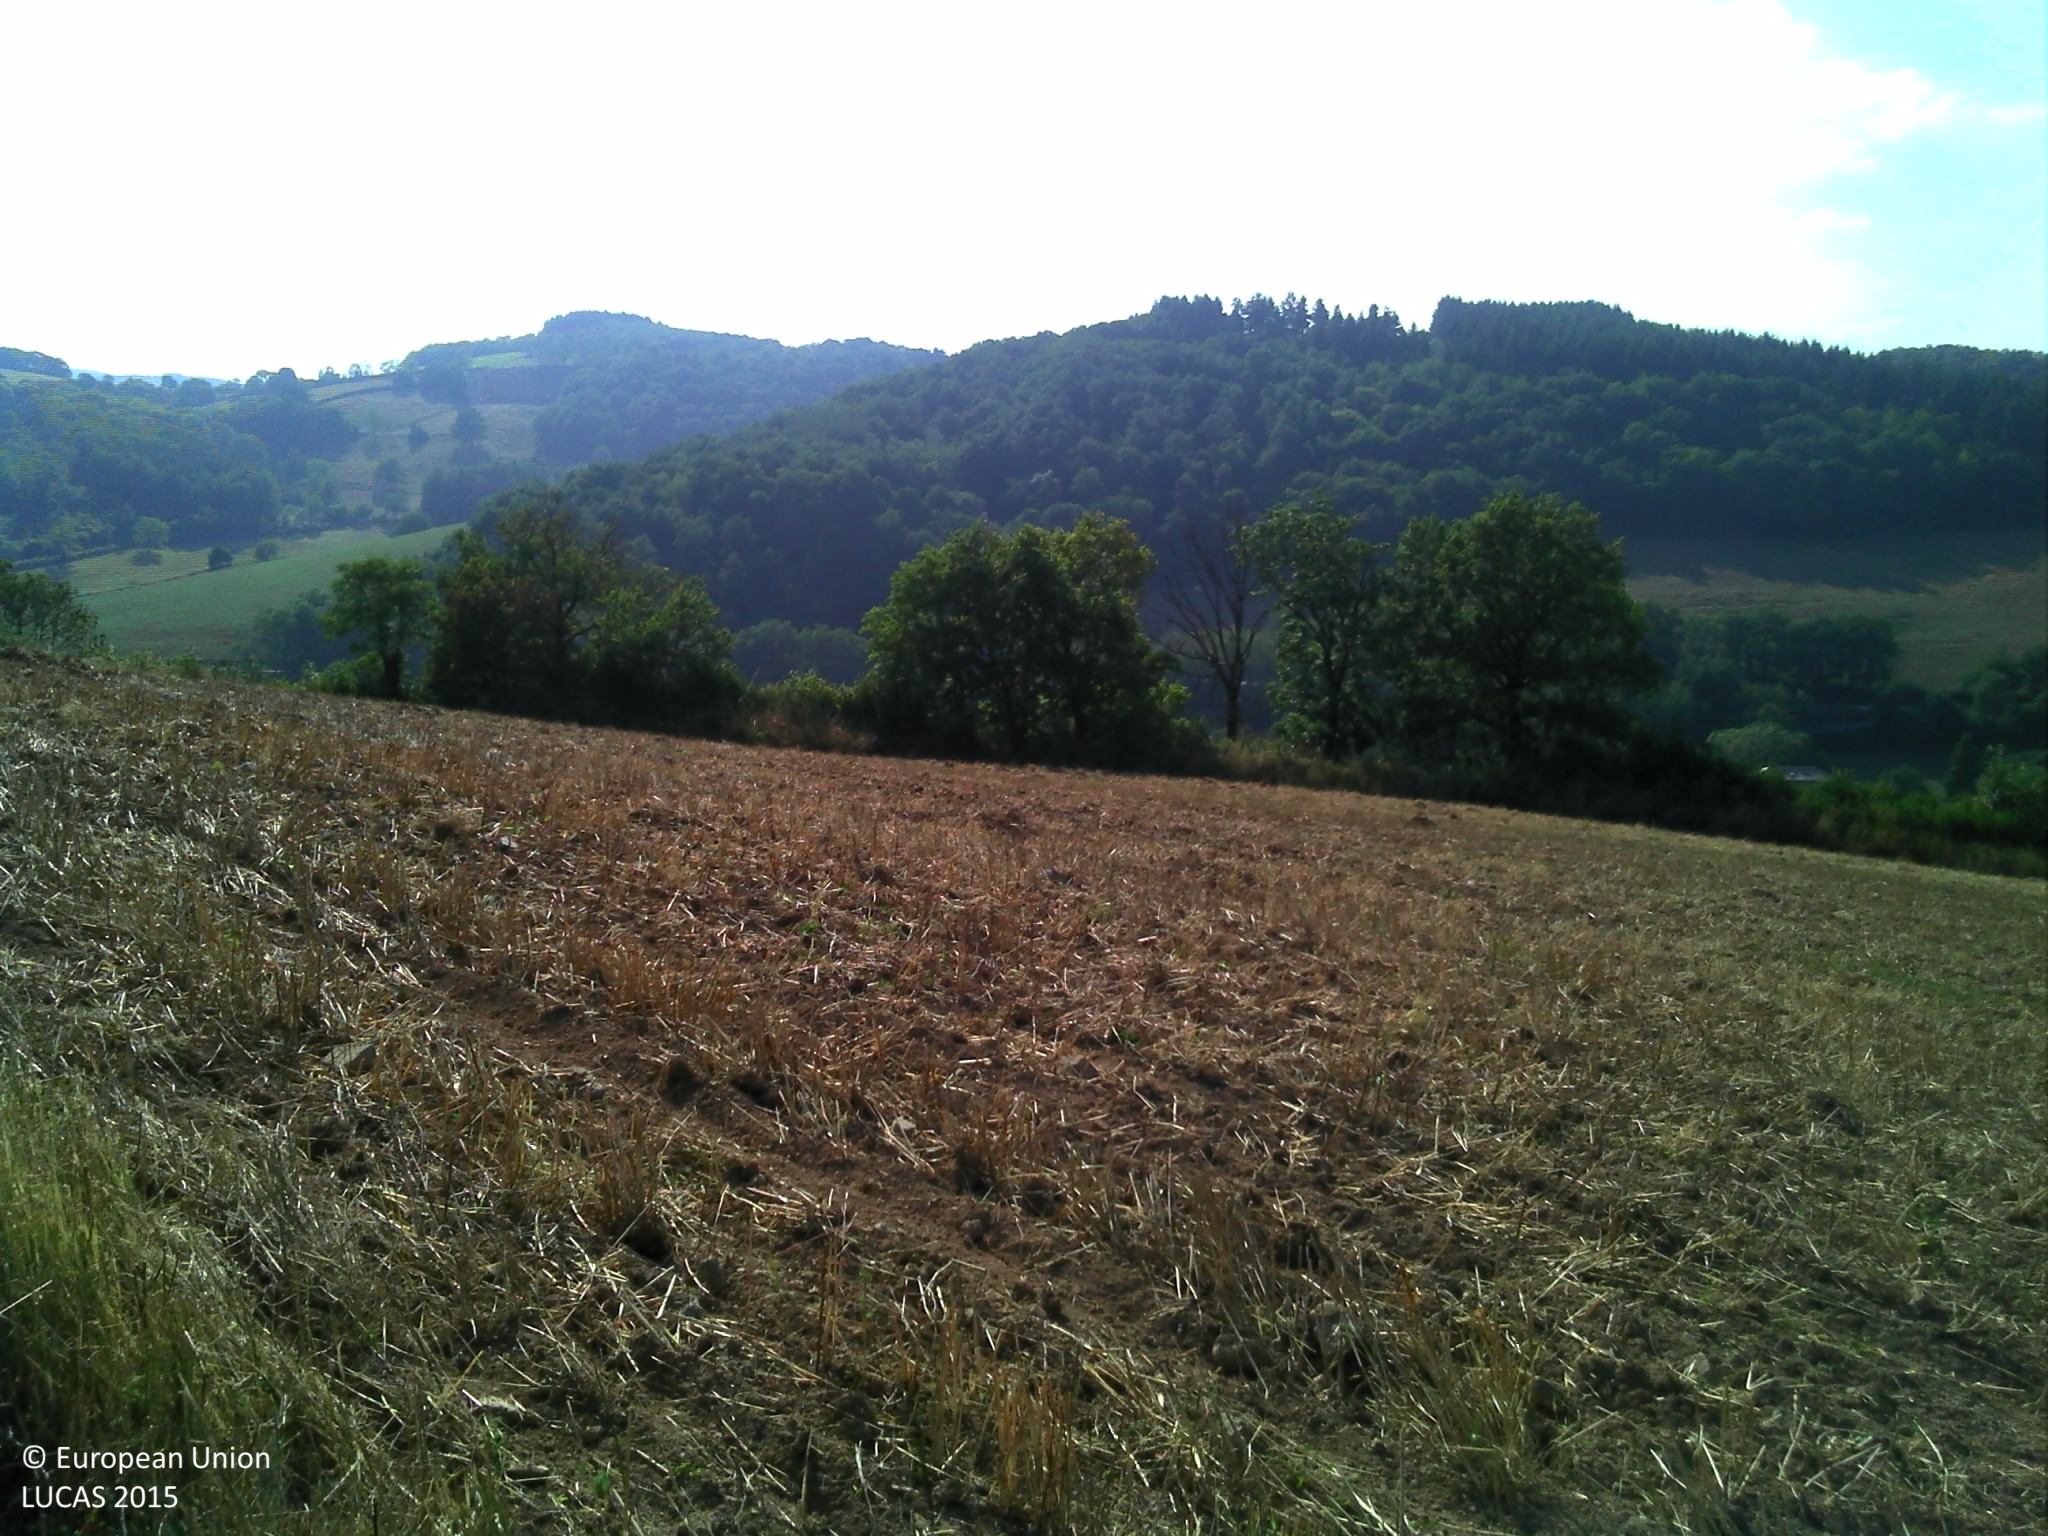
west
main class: Cropland
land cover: Maize
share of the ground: > 75 %
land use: Agriculture (excluding fallow land and kitchen gardens)
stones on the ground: > 50 %
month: August
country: FR
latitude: 46.2852
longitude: 4.5636
